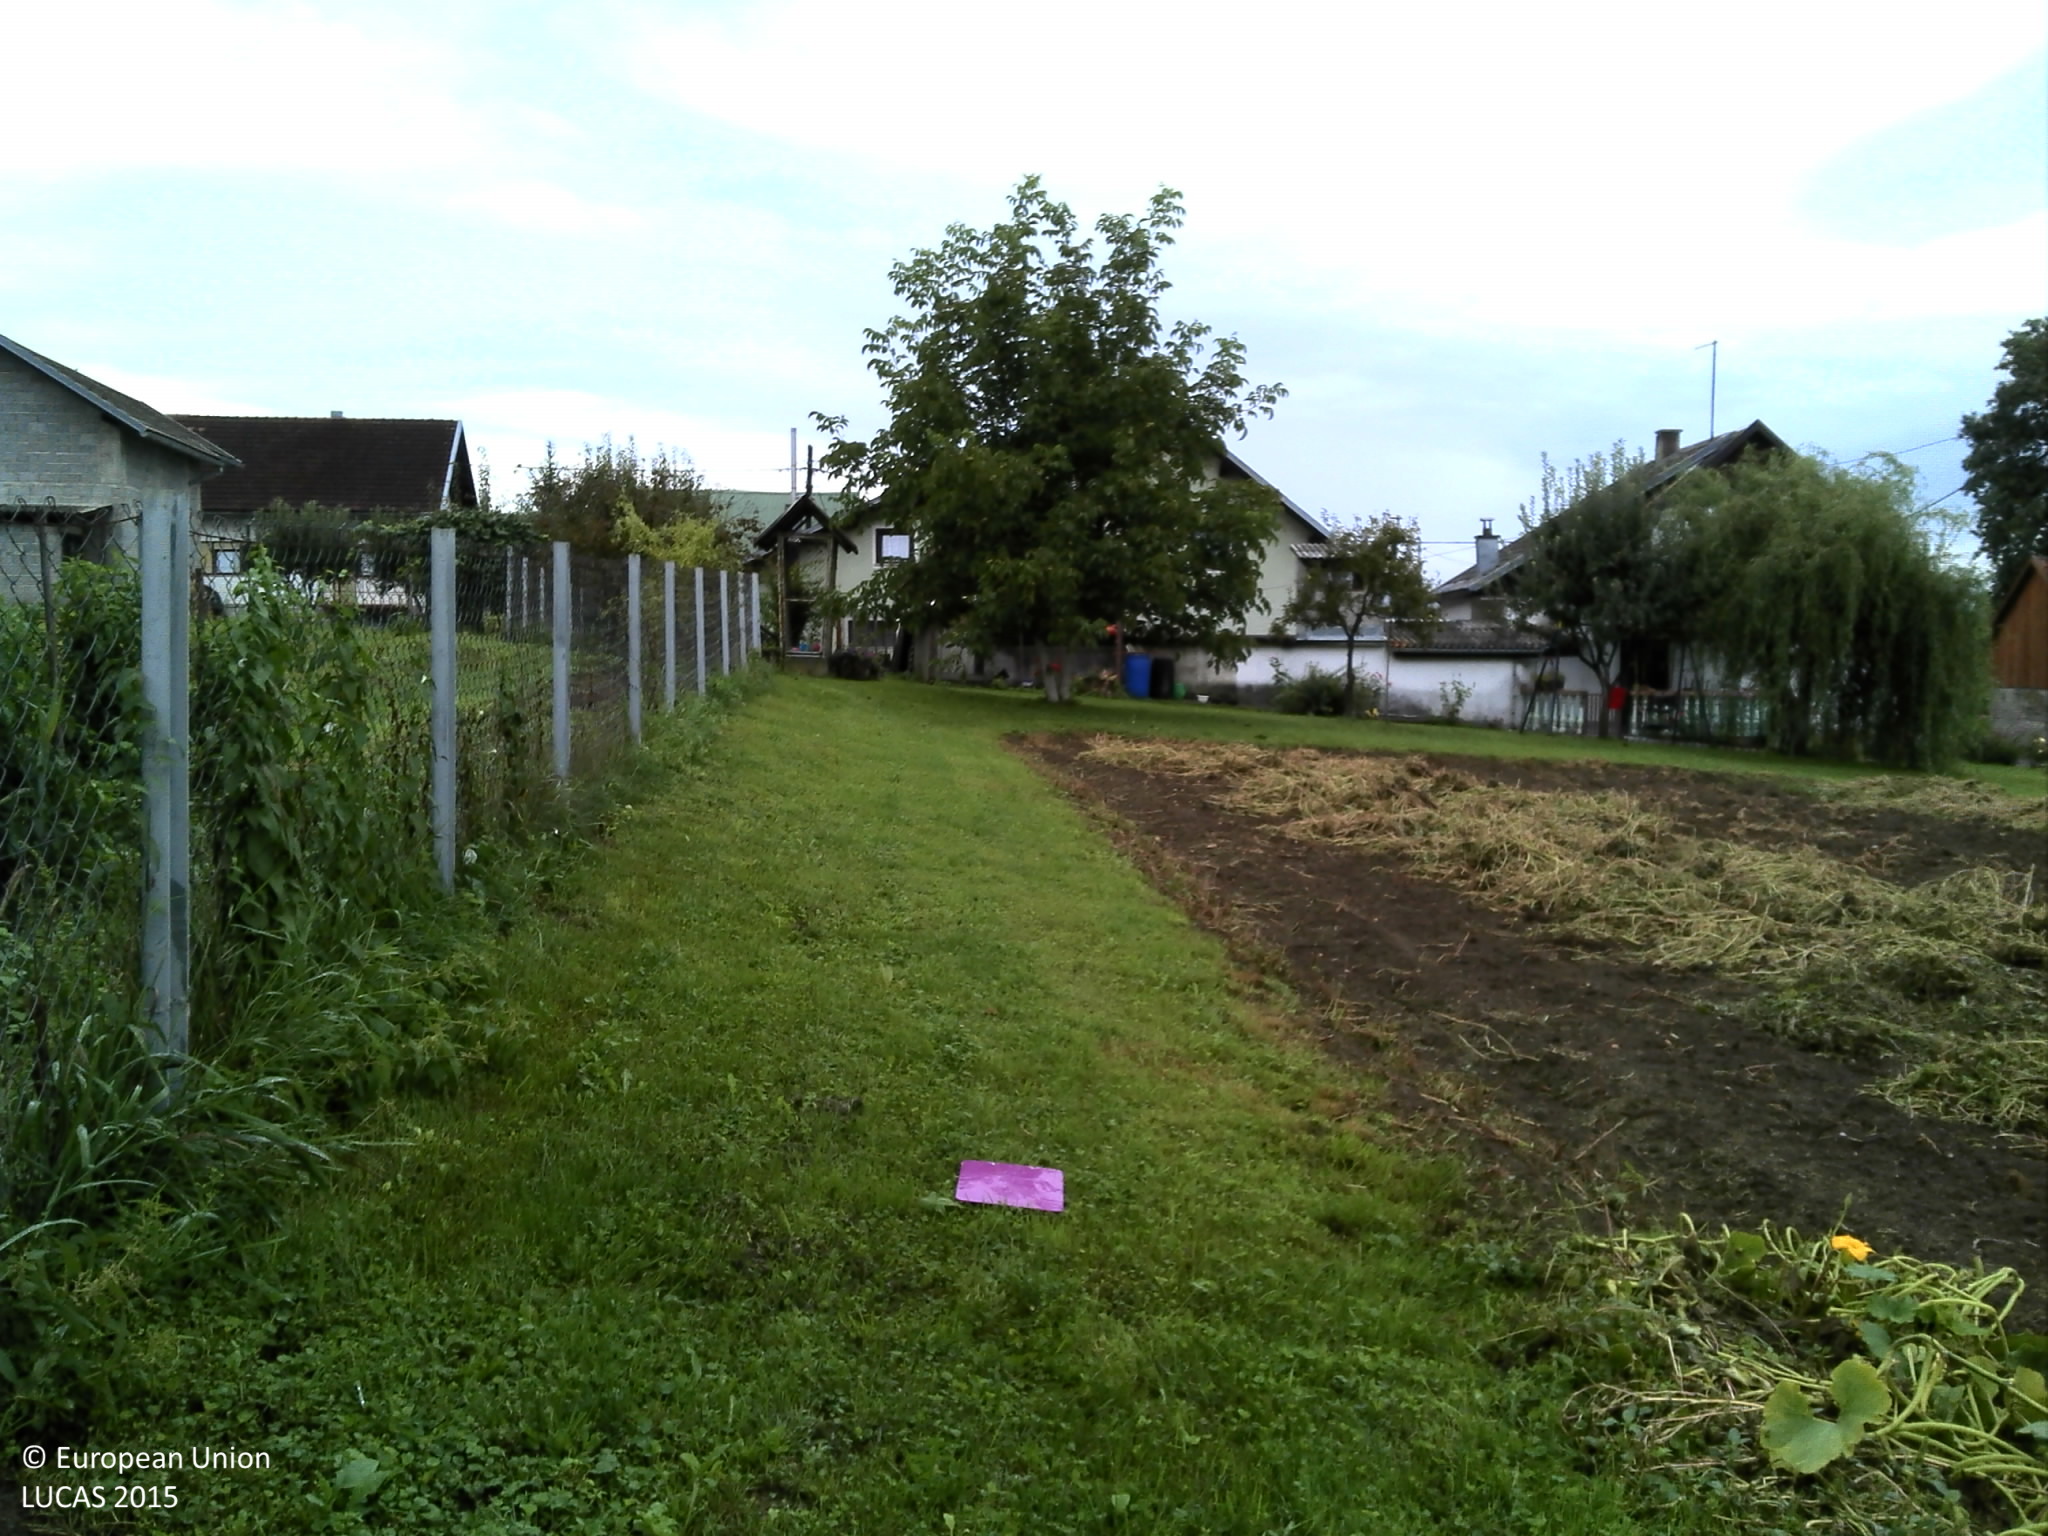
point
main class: Grassland
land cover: Grassland without tree/shrub cover
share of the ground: > 75 %
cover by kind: herbaceous plants 100 %
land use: Residential
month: September
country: HR
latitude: 45.2483
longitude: 15.2318
